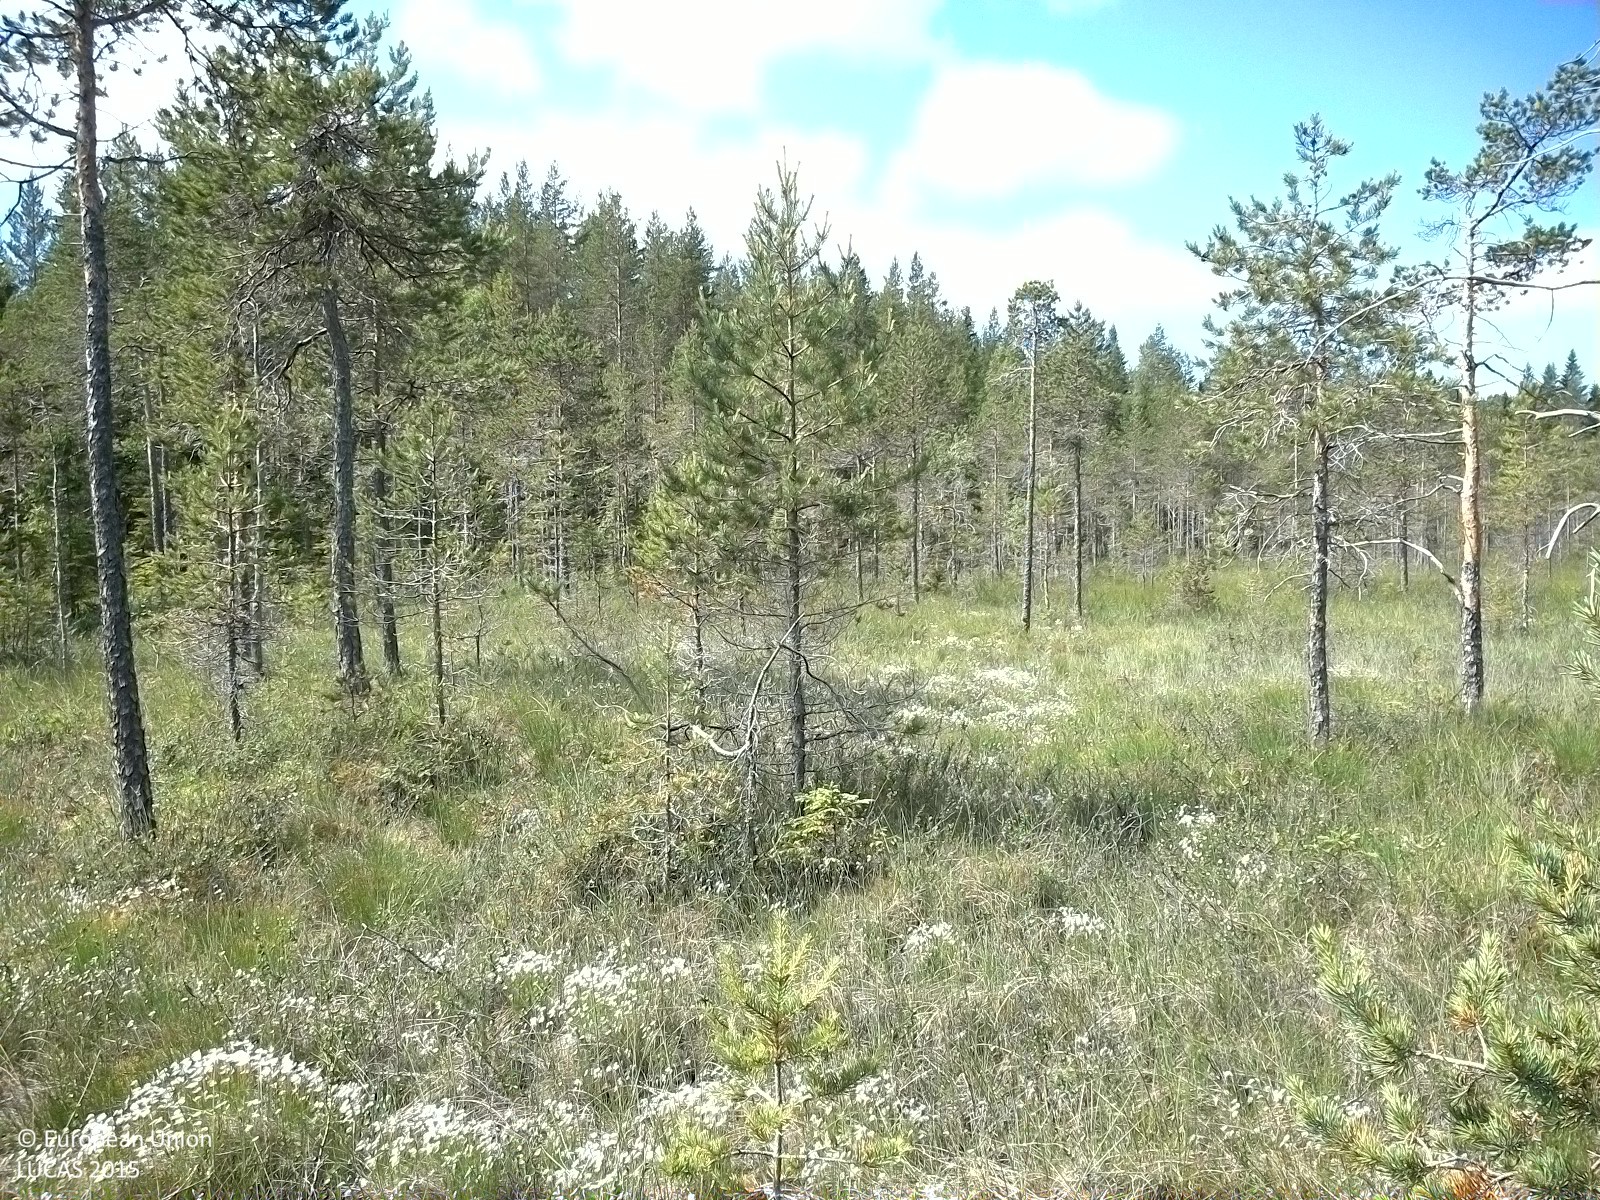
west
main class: Woodland
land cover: Pine dominated coniferous woodland
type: boreal forest
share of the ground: 10 - 25 %
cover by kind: shrubs 55 %, herbaceous plants 30 %, coniferous forest trees 10 %, lichens and mosses 5 %
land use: Semi-natural and natural areas not in use
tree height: < 5 m
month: July
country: SE
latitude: 62.6083
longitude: 17.0903
